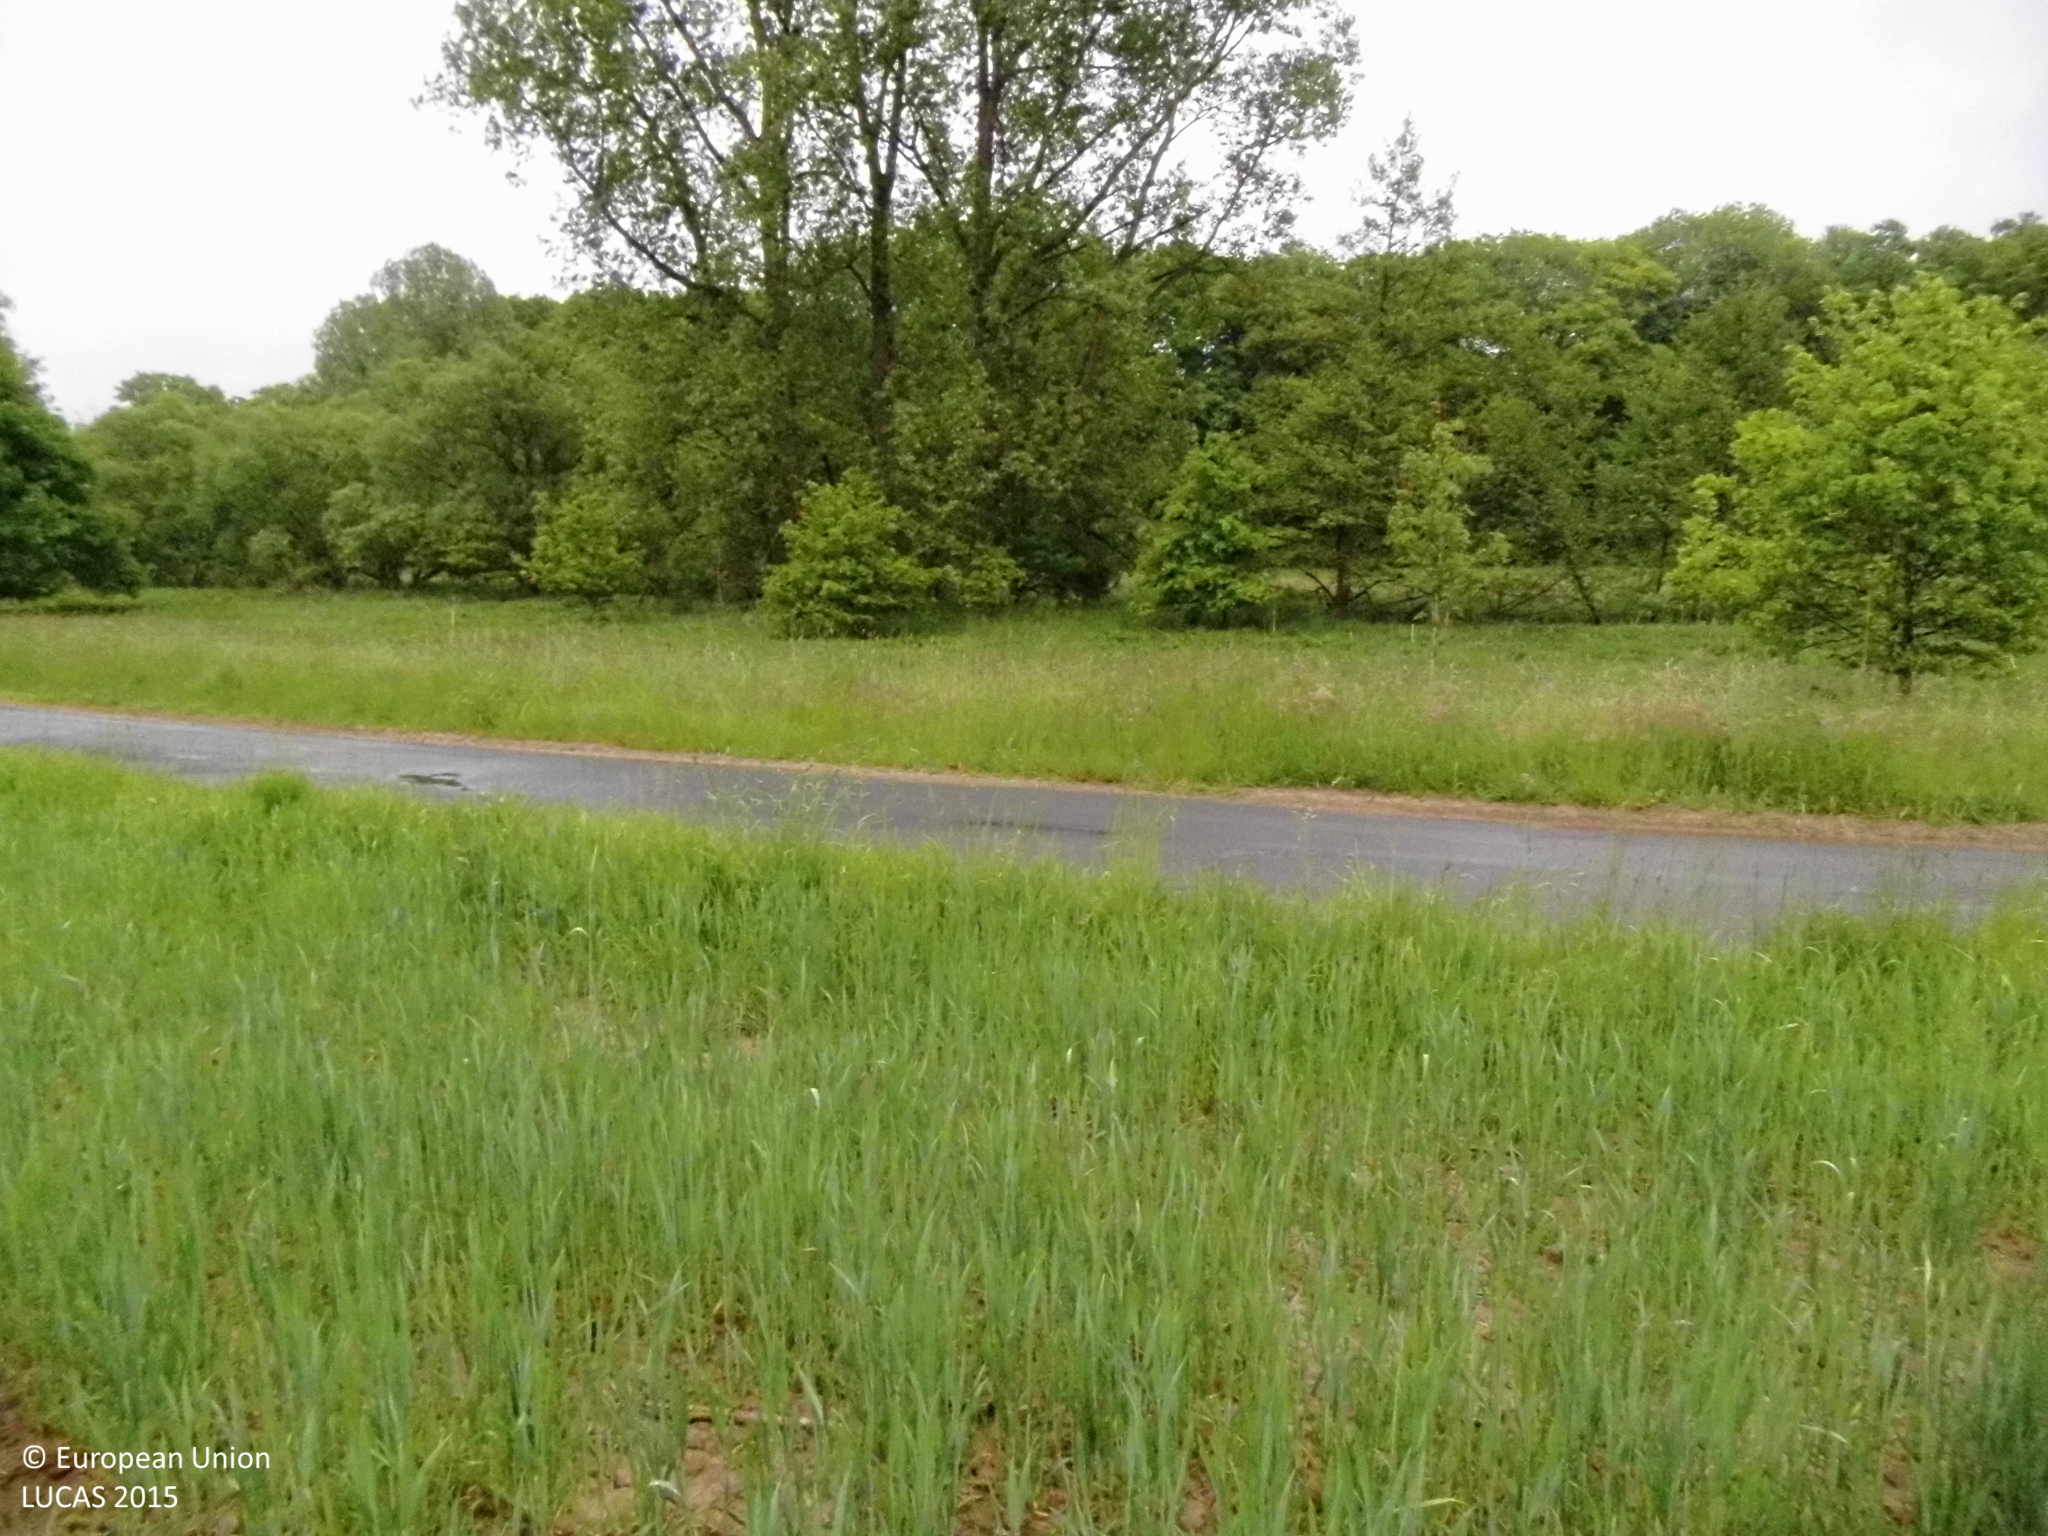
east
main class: Cropland
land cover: Common wheat
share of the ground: > 75 %
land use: Agriculture (excluding fallow land and kitchen gardens)
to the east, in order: Common wheat; Paved roads, cycling and walking lanes; Grassland with sparse tree/shrub cover; Broadleaved woodland; Inland fresh running water; Groves; Grassland without tree/shrub cover; Electric lines; Grassland without tree/shrub cover; Rivers and streams; Grassland without tree/shrub cover; Broadleaved woodland; Grassland without tree/shrub cover
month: May
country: DE
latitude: 50.6970
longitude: 7.5227
